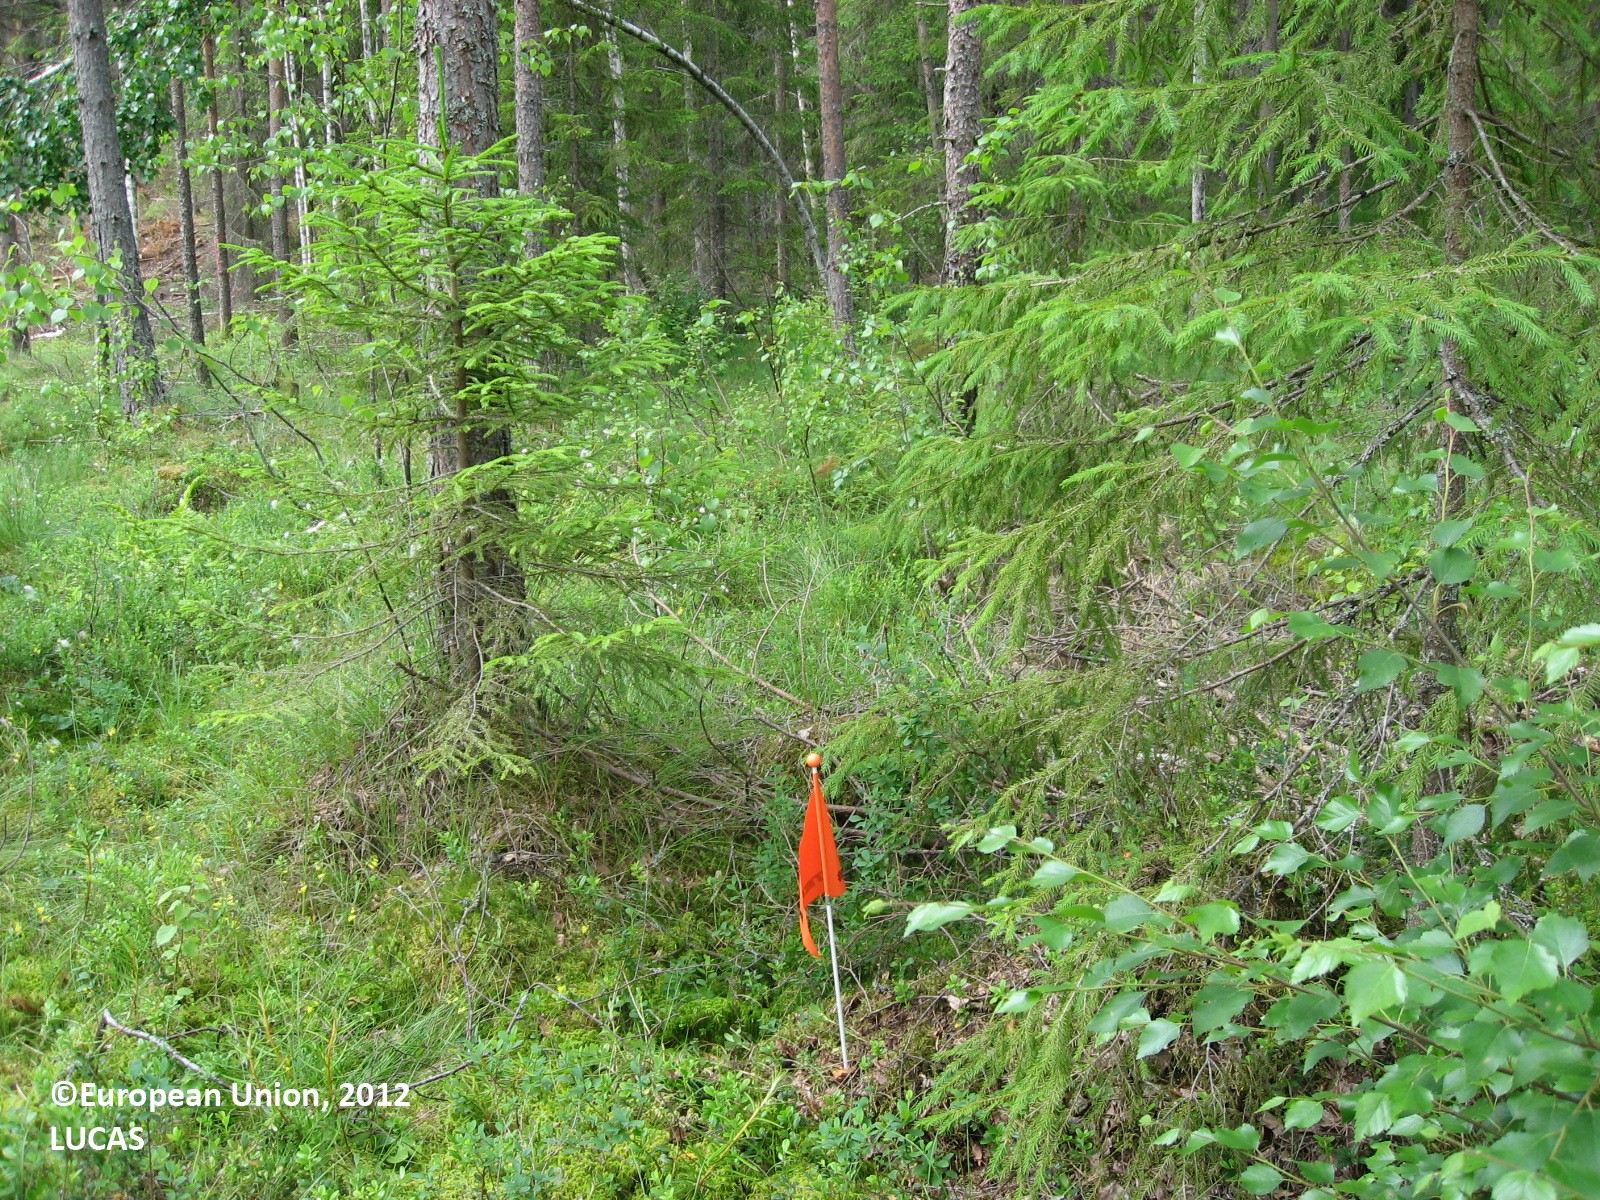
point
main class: Woodland
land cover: Other mixed woodland
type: mire and swamp forests
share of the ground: 25 - 50 %
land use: Forestry
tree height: > 5 m
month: July
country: FI
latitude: 60.8927
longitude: 26.5370
